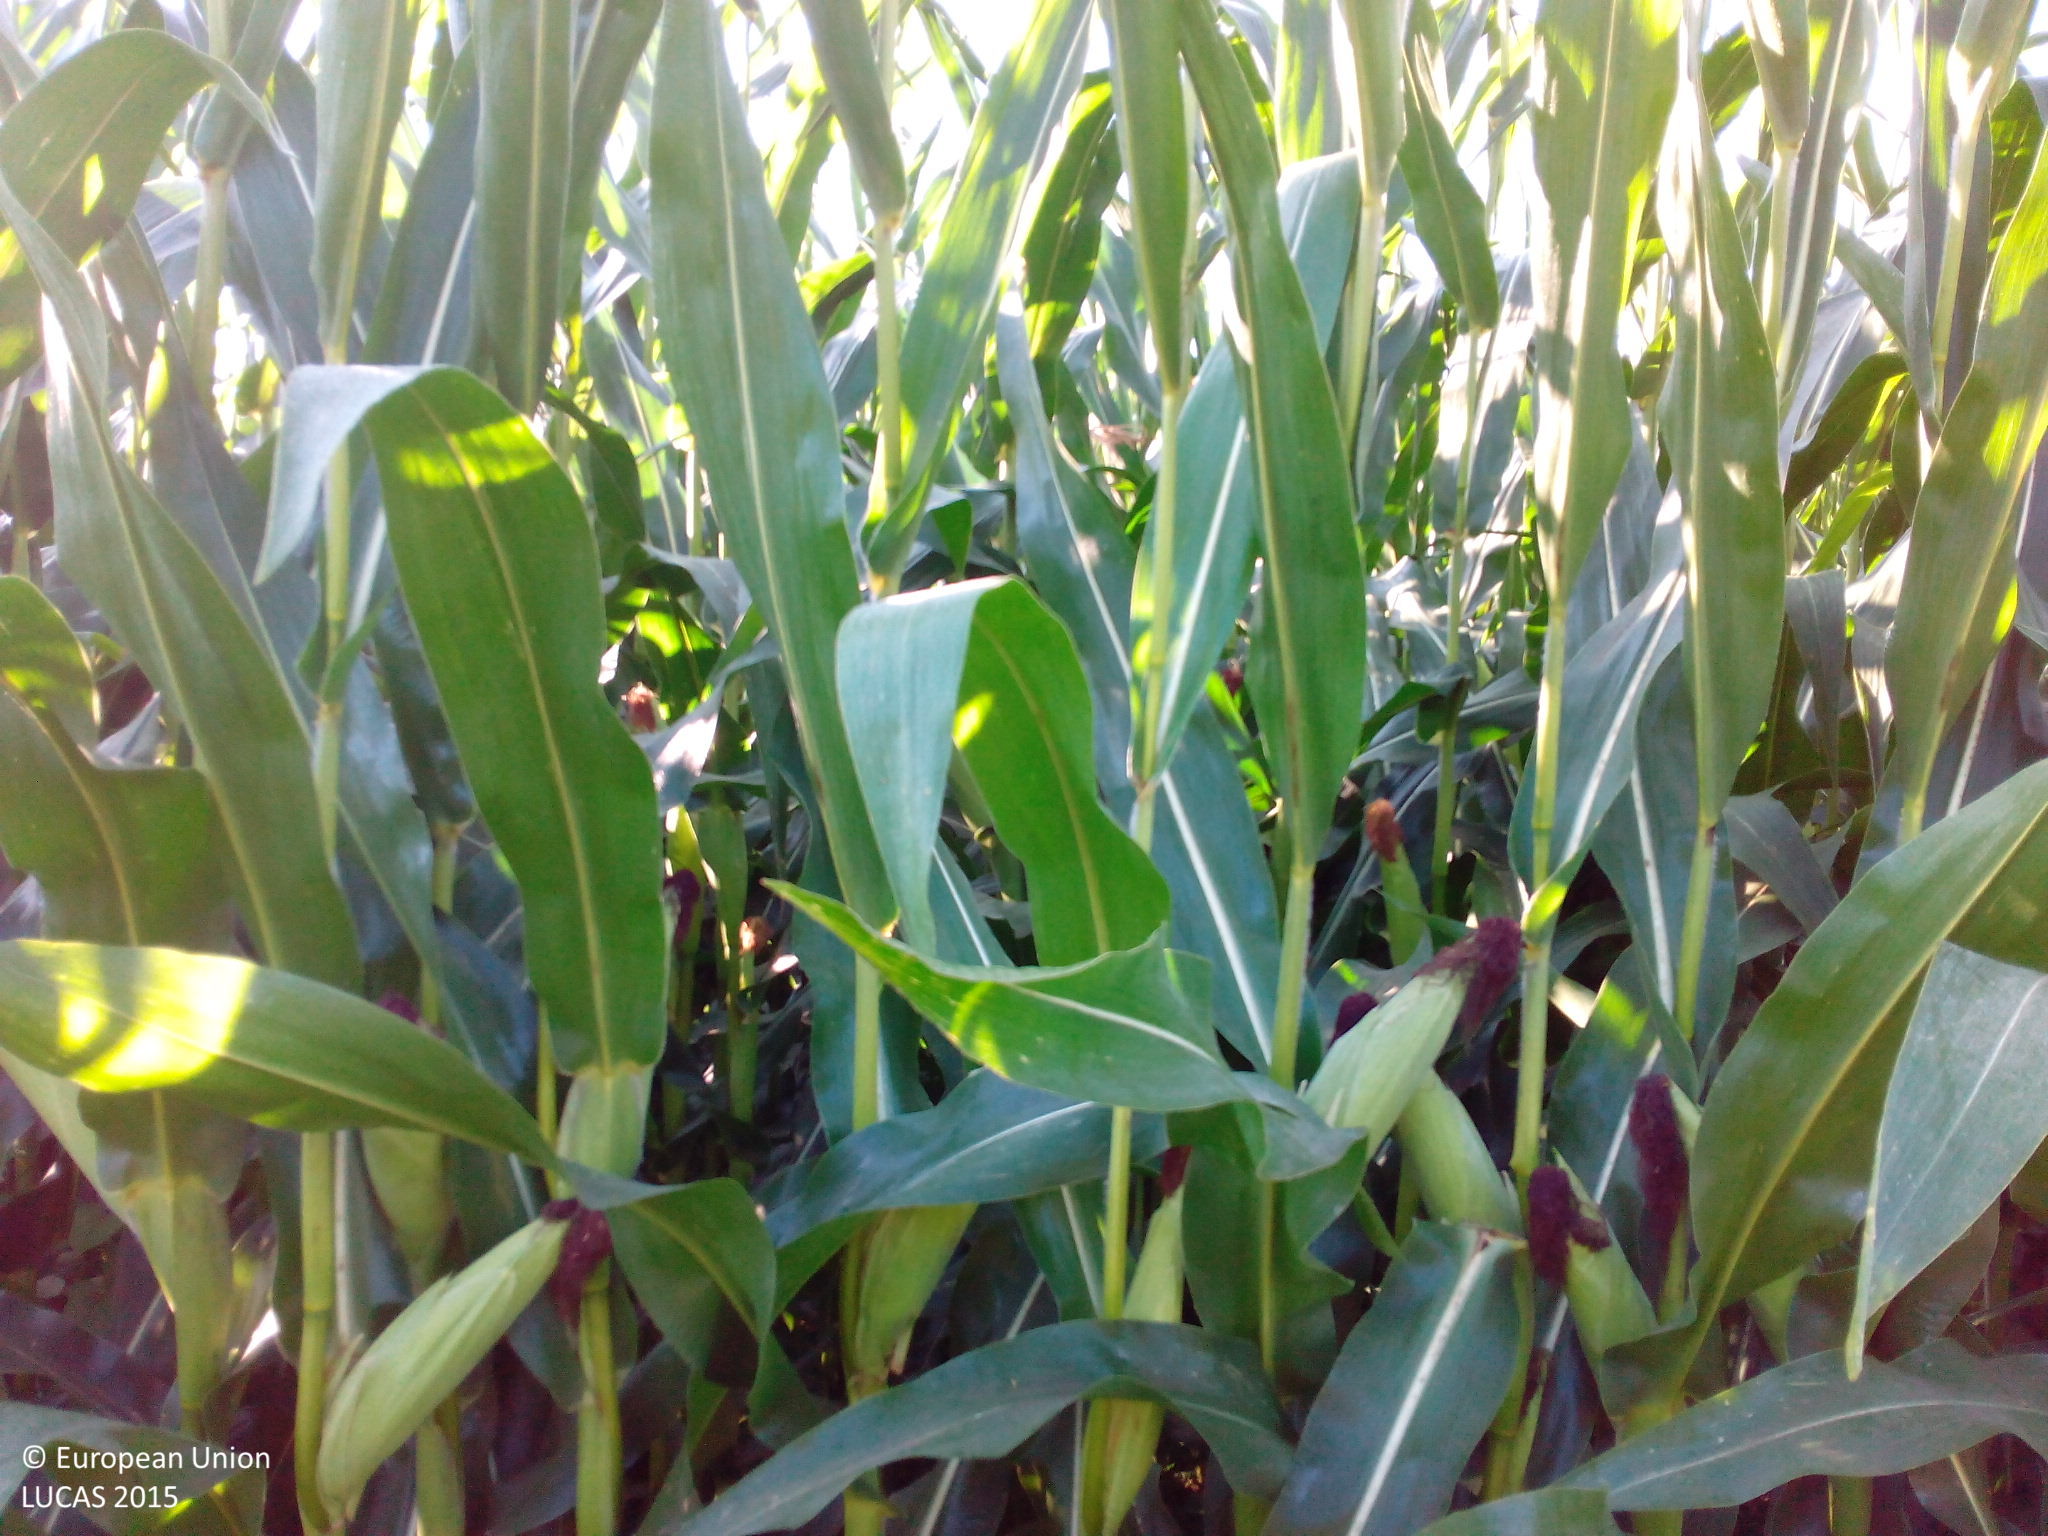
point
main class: Cropland
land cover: Maize
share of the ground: > 75 %
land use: Agriculture (excluding fallow land and kitchen gardens)
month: August
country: DE
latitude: 48.0259
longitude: 12.8014
